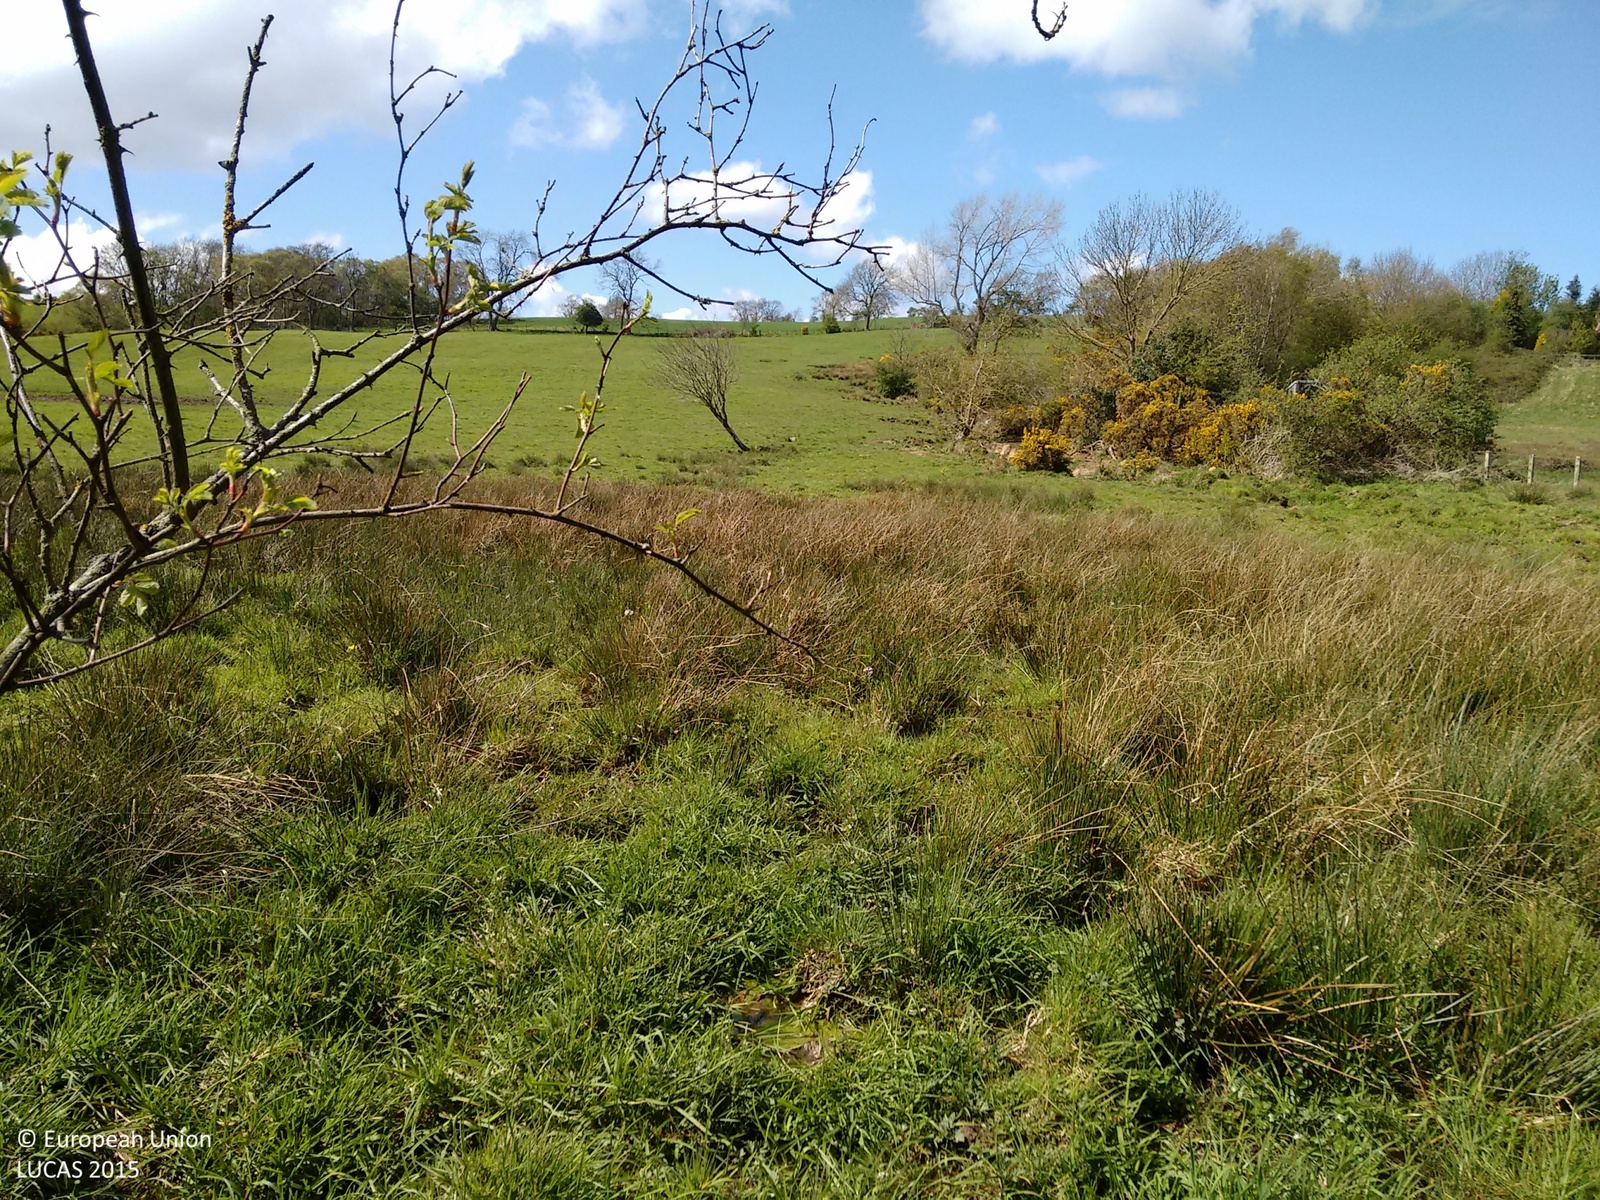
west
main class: Grassland
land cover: Grassland without tree/shrub cover
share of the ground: > 75 %
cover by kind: herbaceous plants 100 %
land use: Agriculture (excluding fallow land and kitchen gardens)
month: May
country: GB
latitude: 54.9490
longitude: -1.9988
